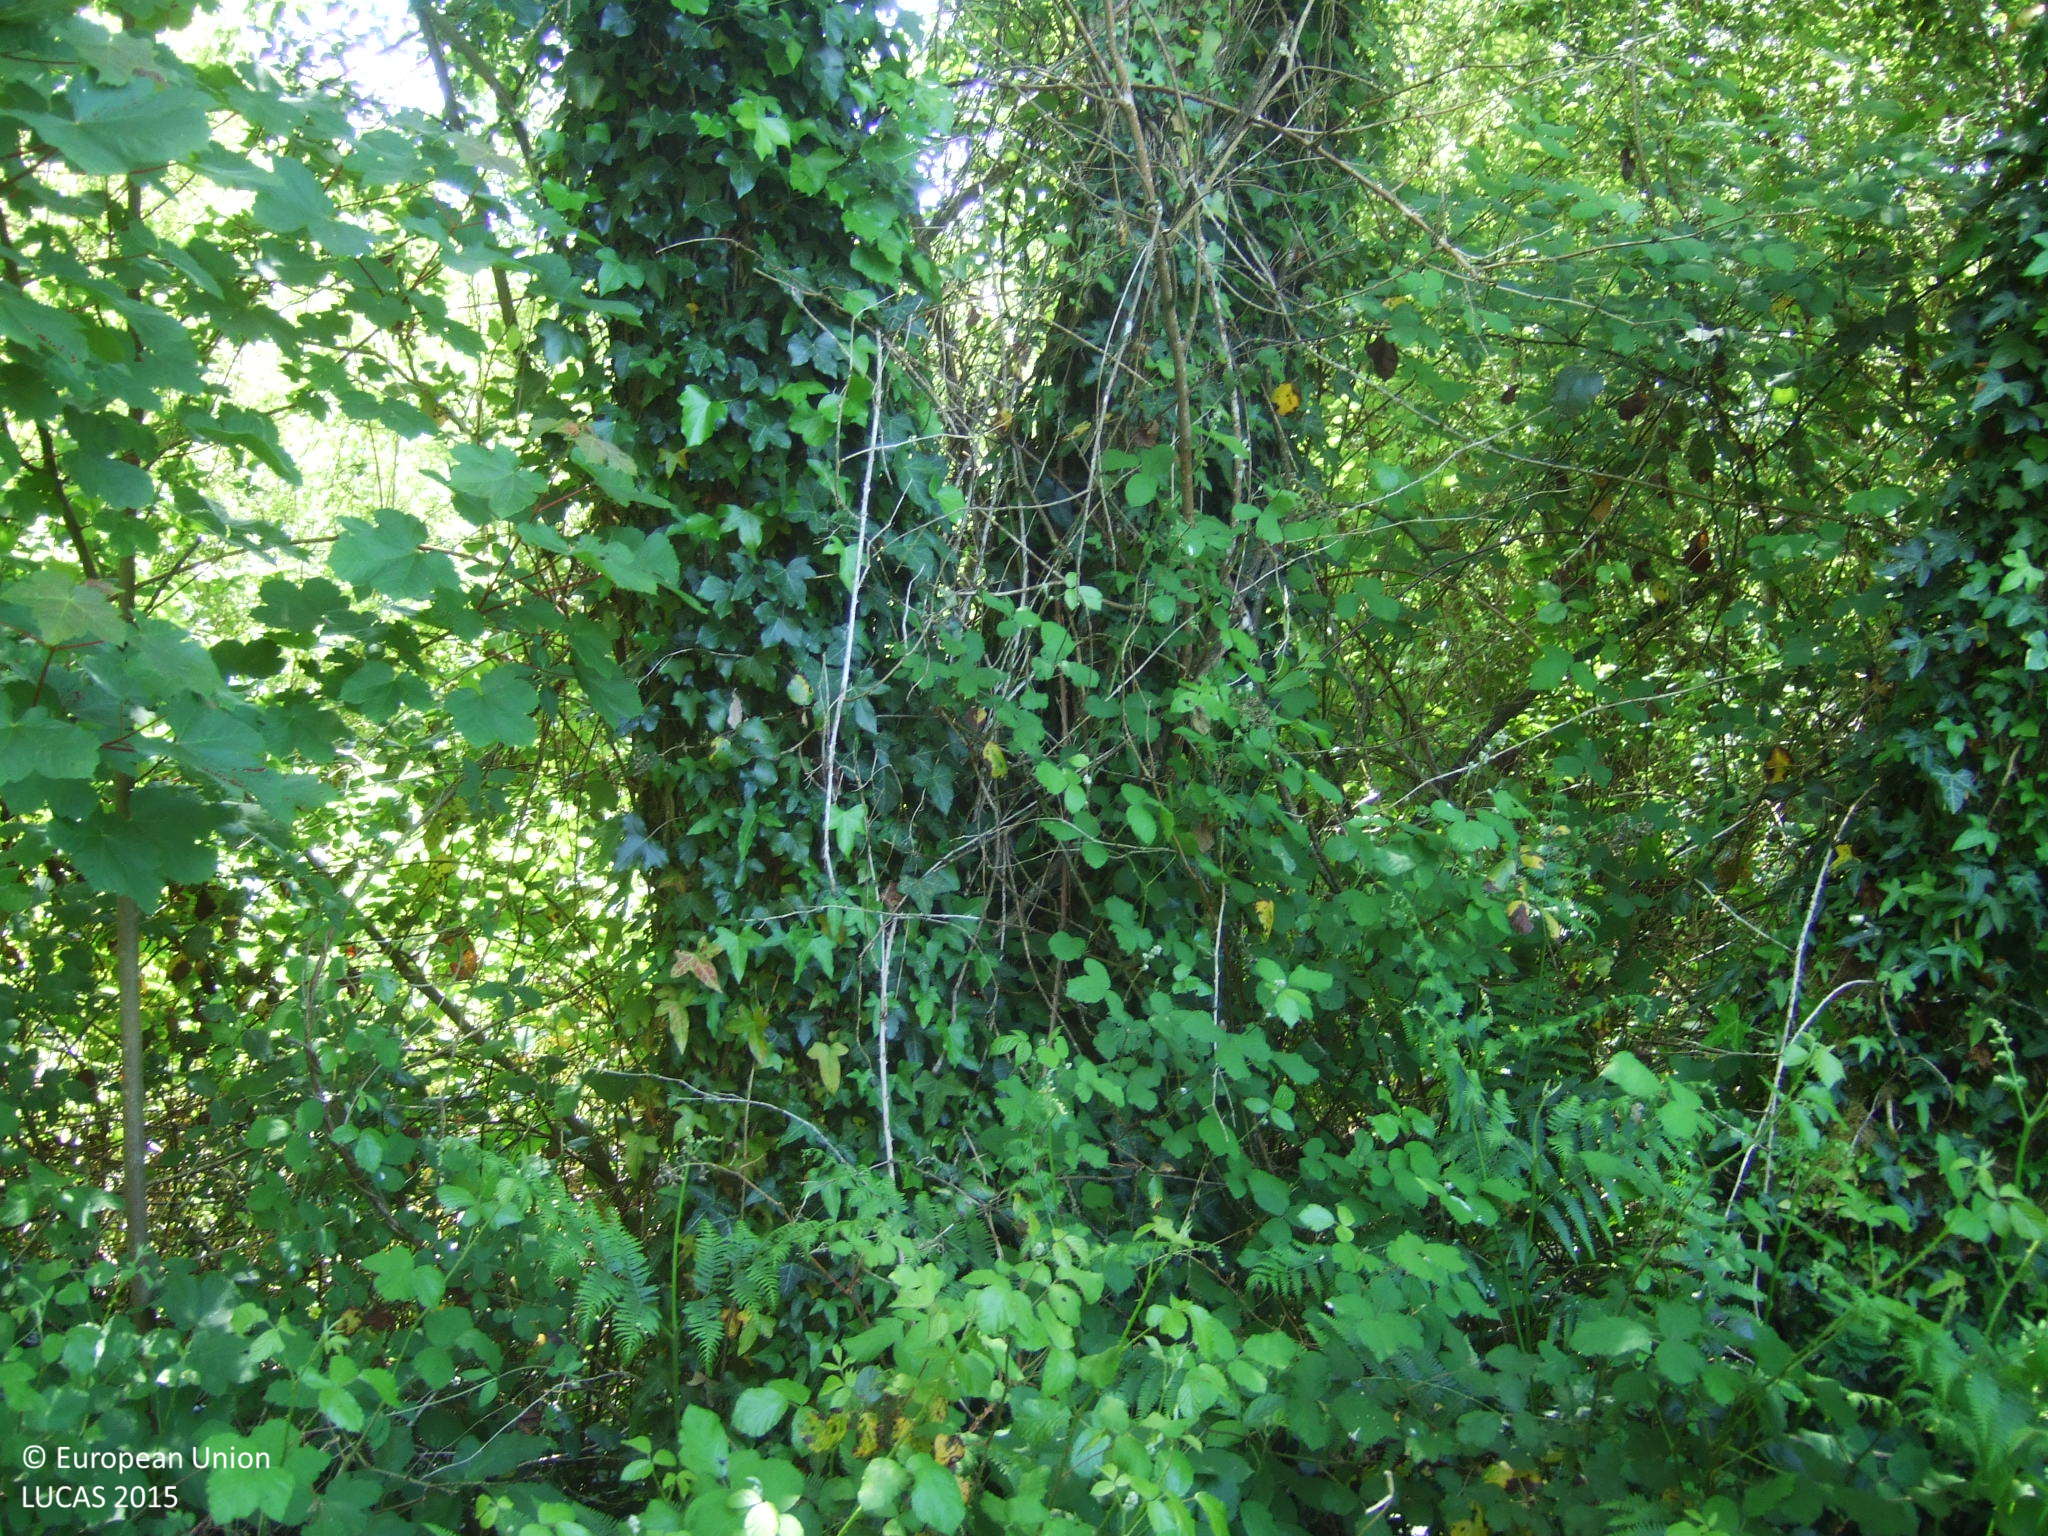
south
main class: Grassland
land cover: Grassland without tree/shrub cover
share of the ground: > 75 %
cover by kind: herbaceous plants 100 %
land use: Agriculture (excluding fallow land and kitchen gardens)
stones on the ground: < 10 %
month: May
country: ES
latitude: 43.2412
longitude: -7.6818
